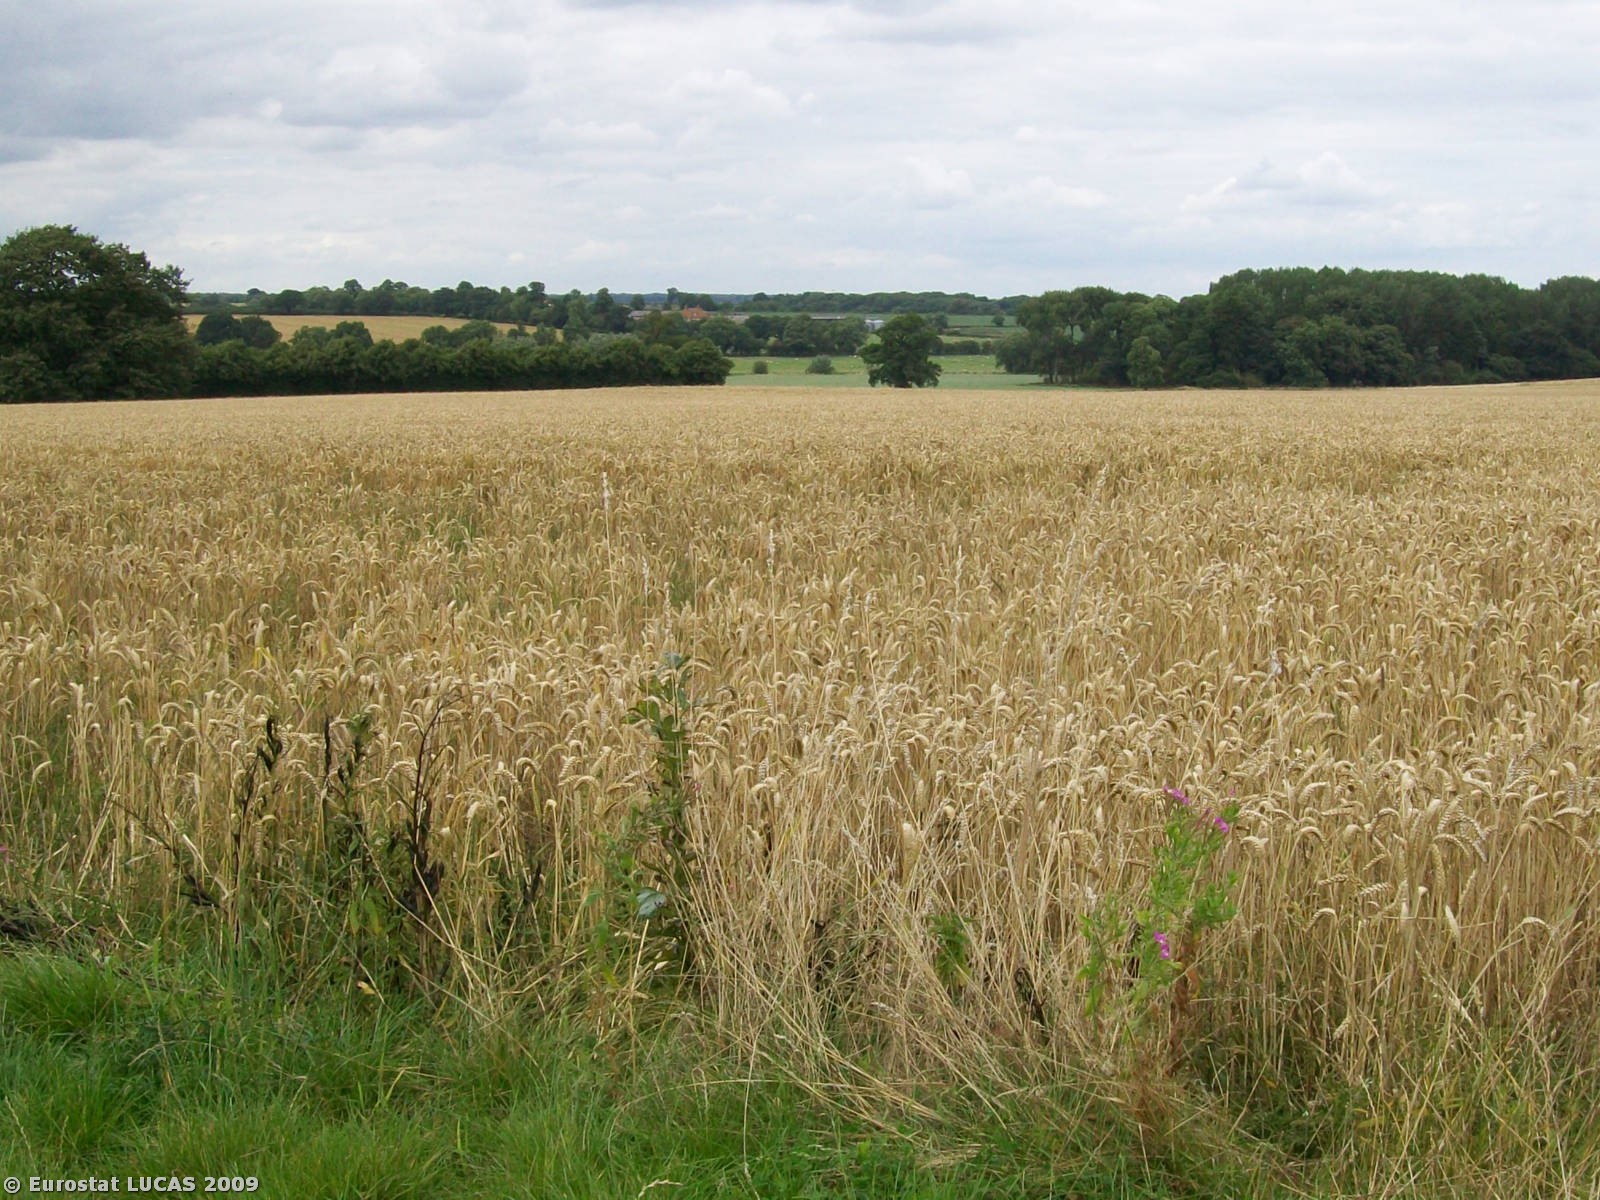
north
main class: Cropland
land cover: Common wheat
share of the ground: > 75 %
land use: Agriculture (excluding fallow land and kitchen gardens)
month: August
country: GB
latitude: 52.0192
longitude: -0.8993
